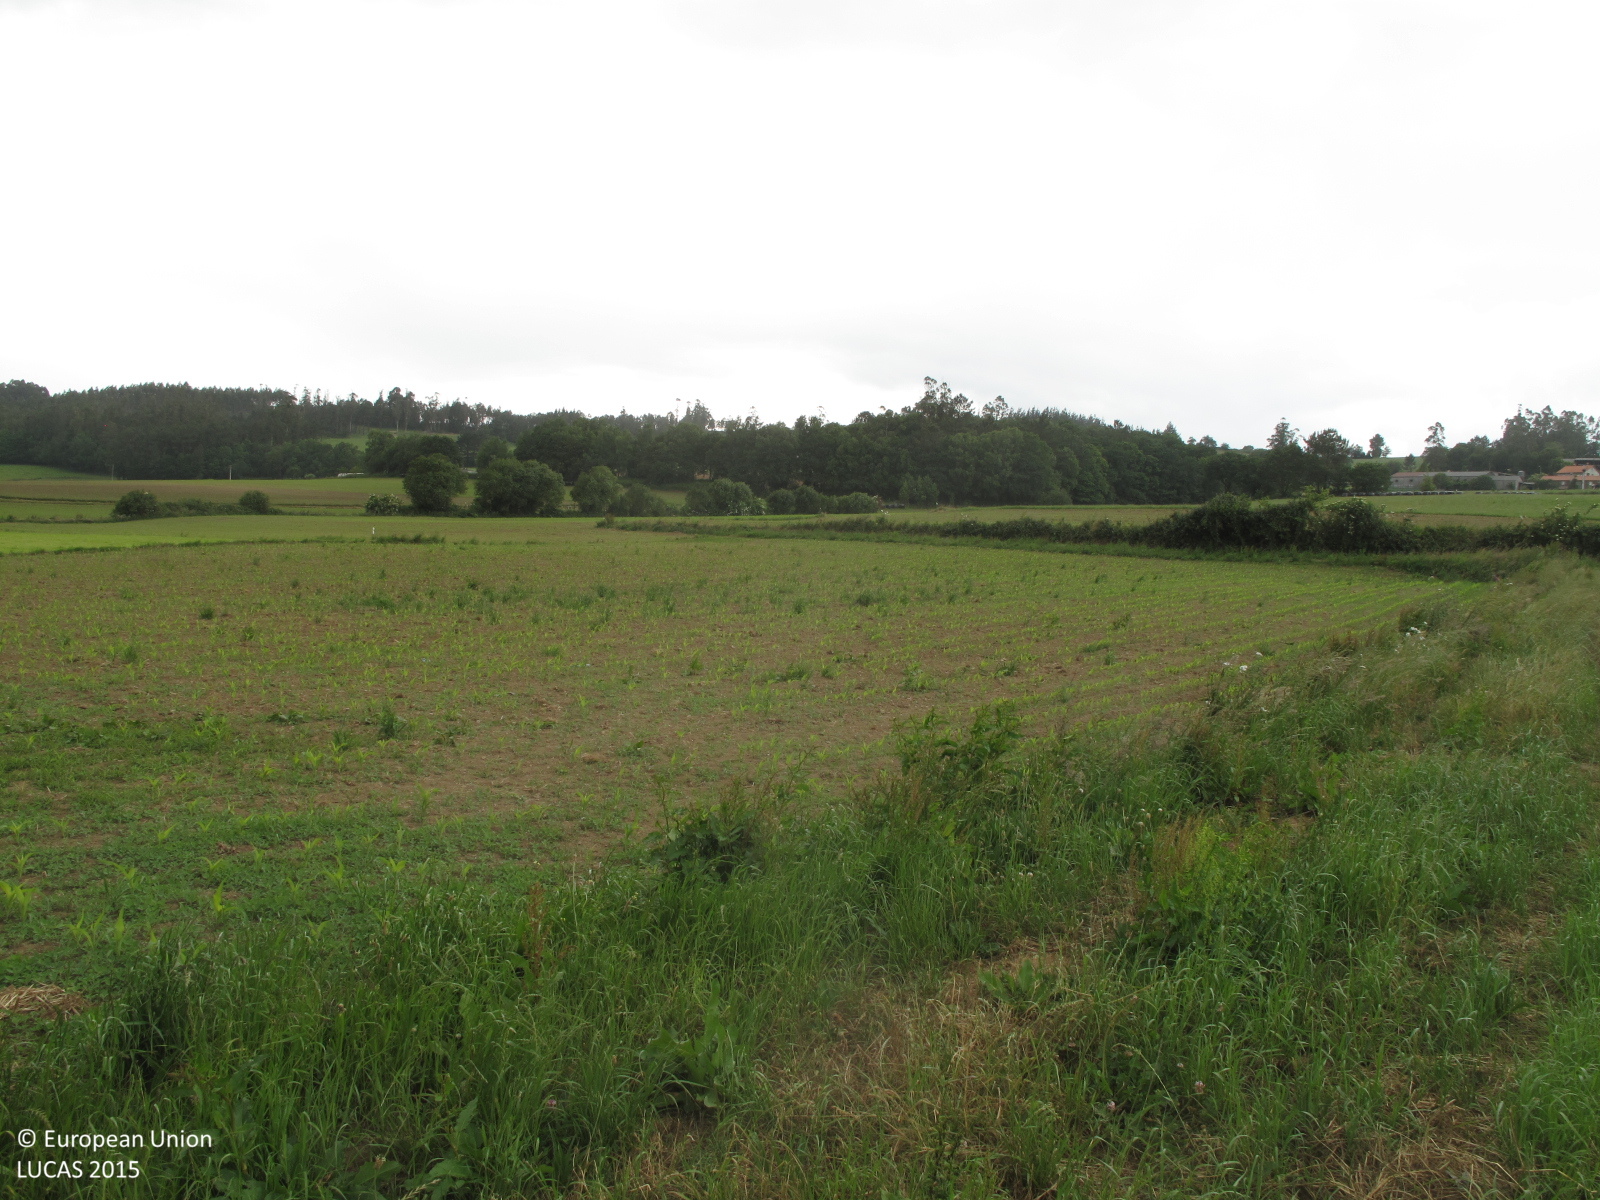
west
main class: Cropland
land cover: Maize
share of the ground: < 10 %
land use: Agriculture (excluding fallow land and kitchen gardens)
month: June
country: ES
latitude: 43.0725
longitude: -8.5160
